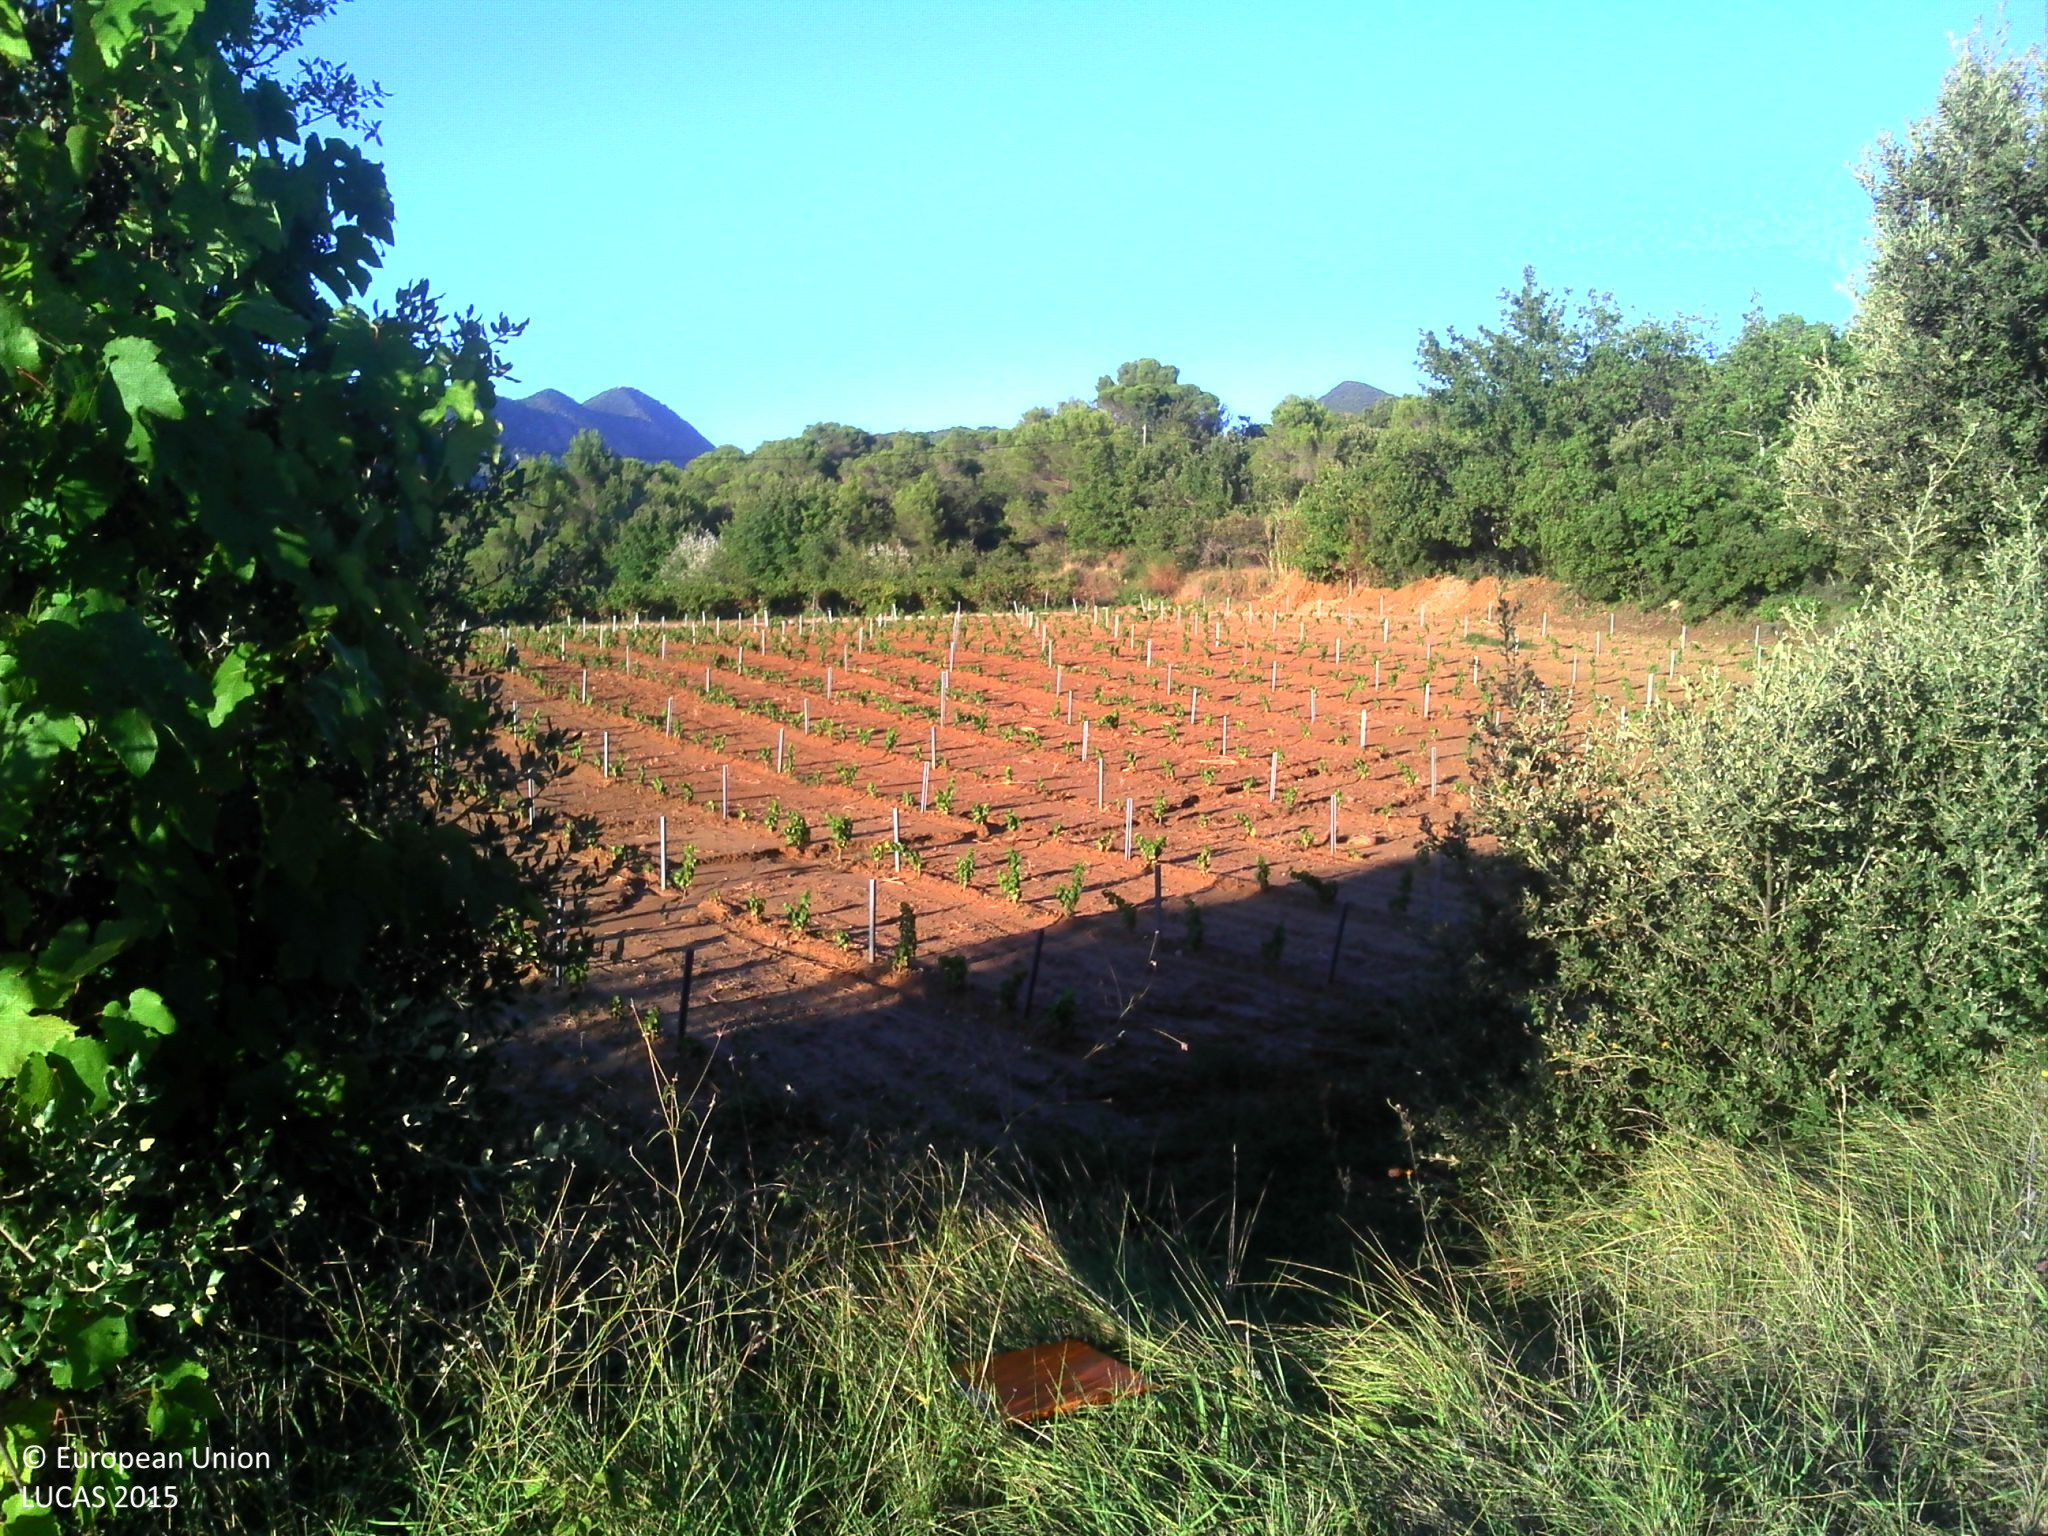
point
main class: Cropland
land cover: Vineyards
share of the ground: 10 - 25 %
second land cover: Other bare soil
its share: > 75 %
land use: Agriculture (excluding fallow land and kitchen gardens)
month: September
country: FR
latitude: 44.2894
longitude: 5.1076
